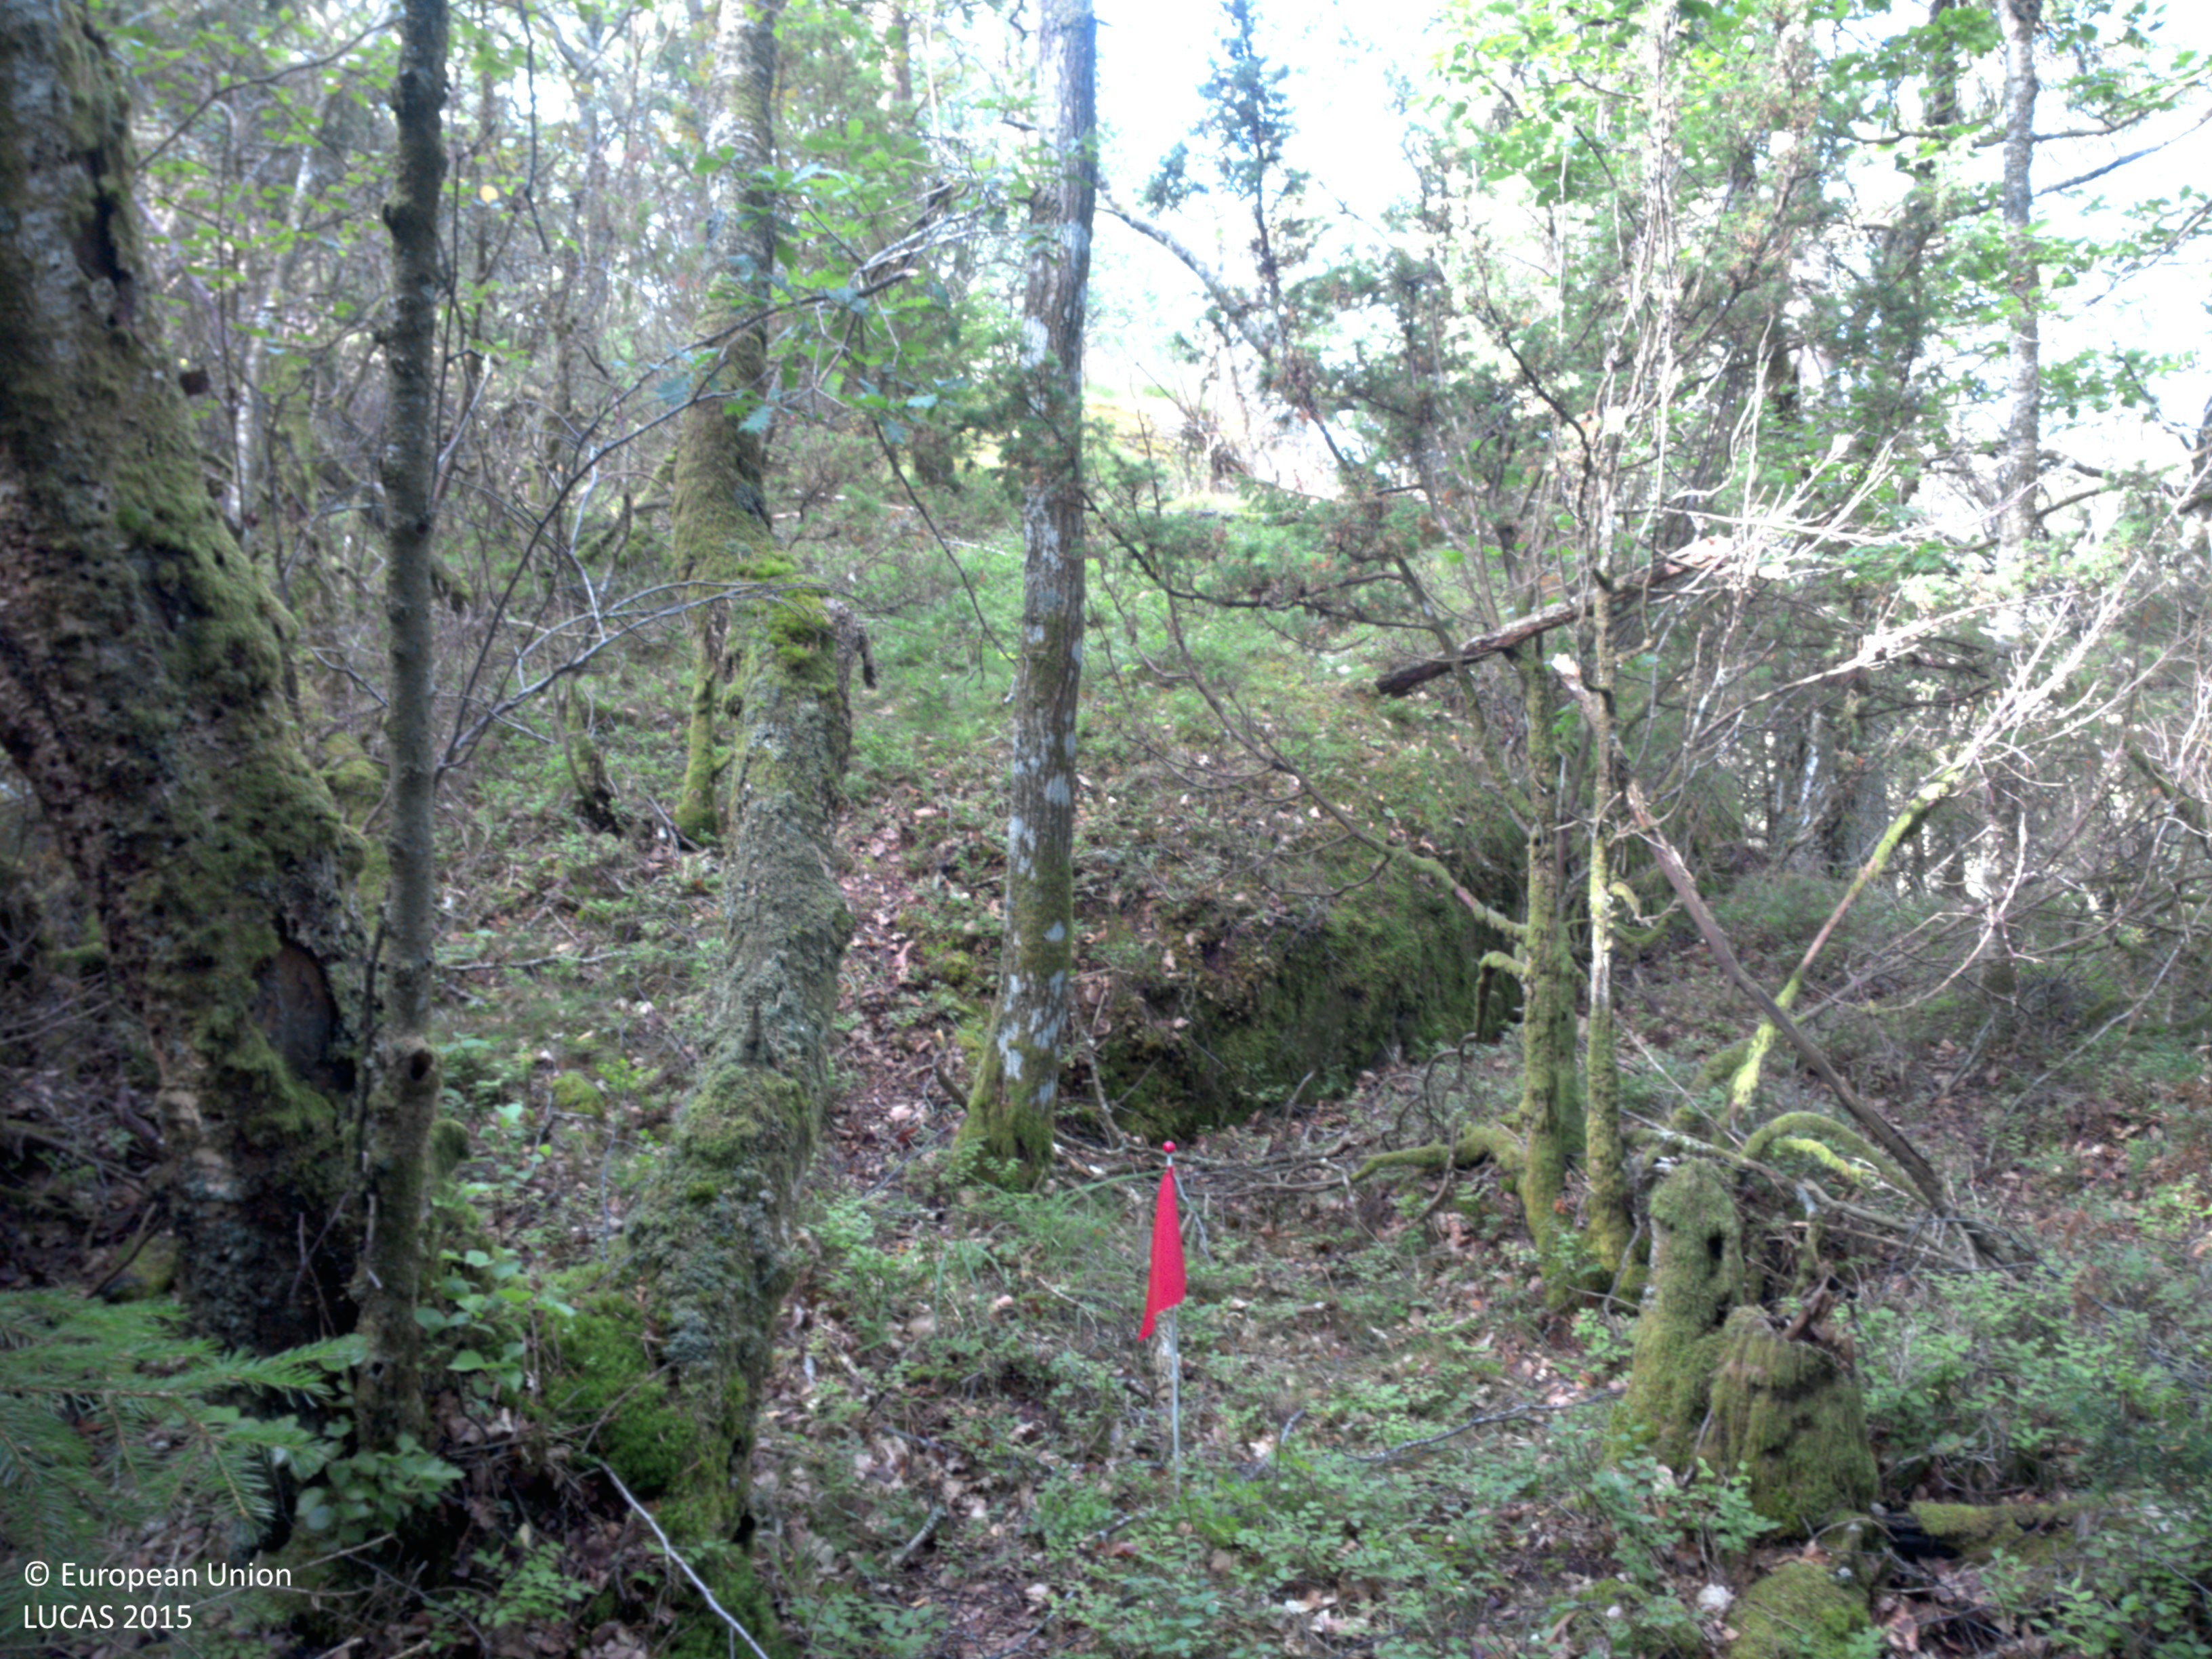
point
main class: Woodland
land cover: Spruce dominated mixed woodland
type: boreal forest
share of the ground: > 75 %
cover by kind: coniferous forest trees 40 %, broadleaved forest trees 35 %, herbaceous plants 25 %
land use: Forestry
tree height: > 5 m
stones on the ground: < 10 %
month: July
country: SE
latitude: 58.1742
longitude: 11.5781
